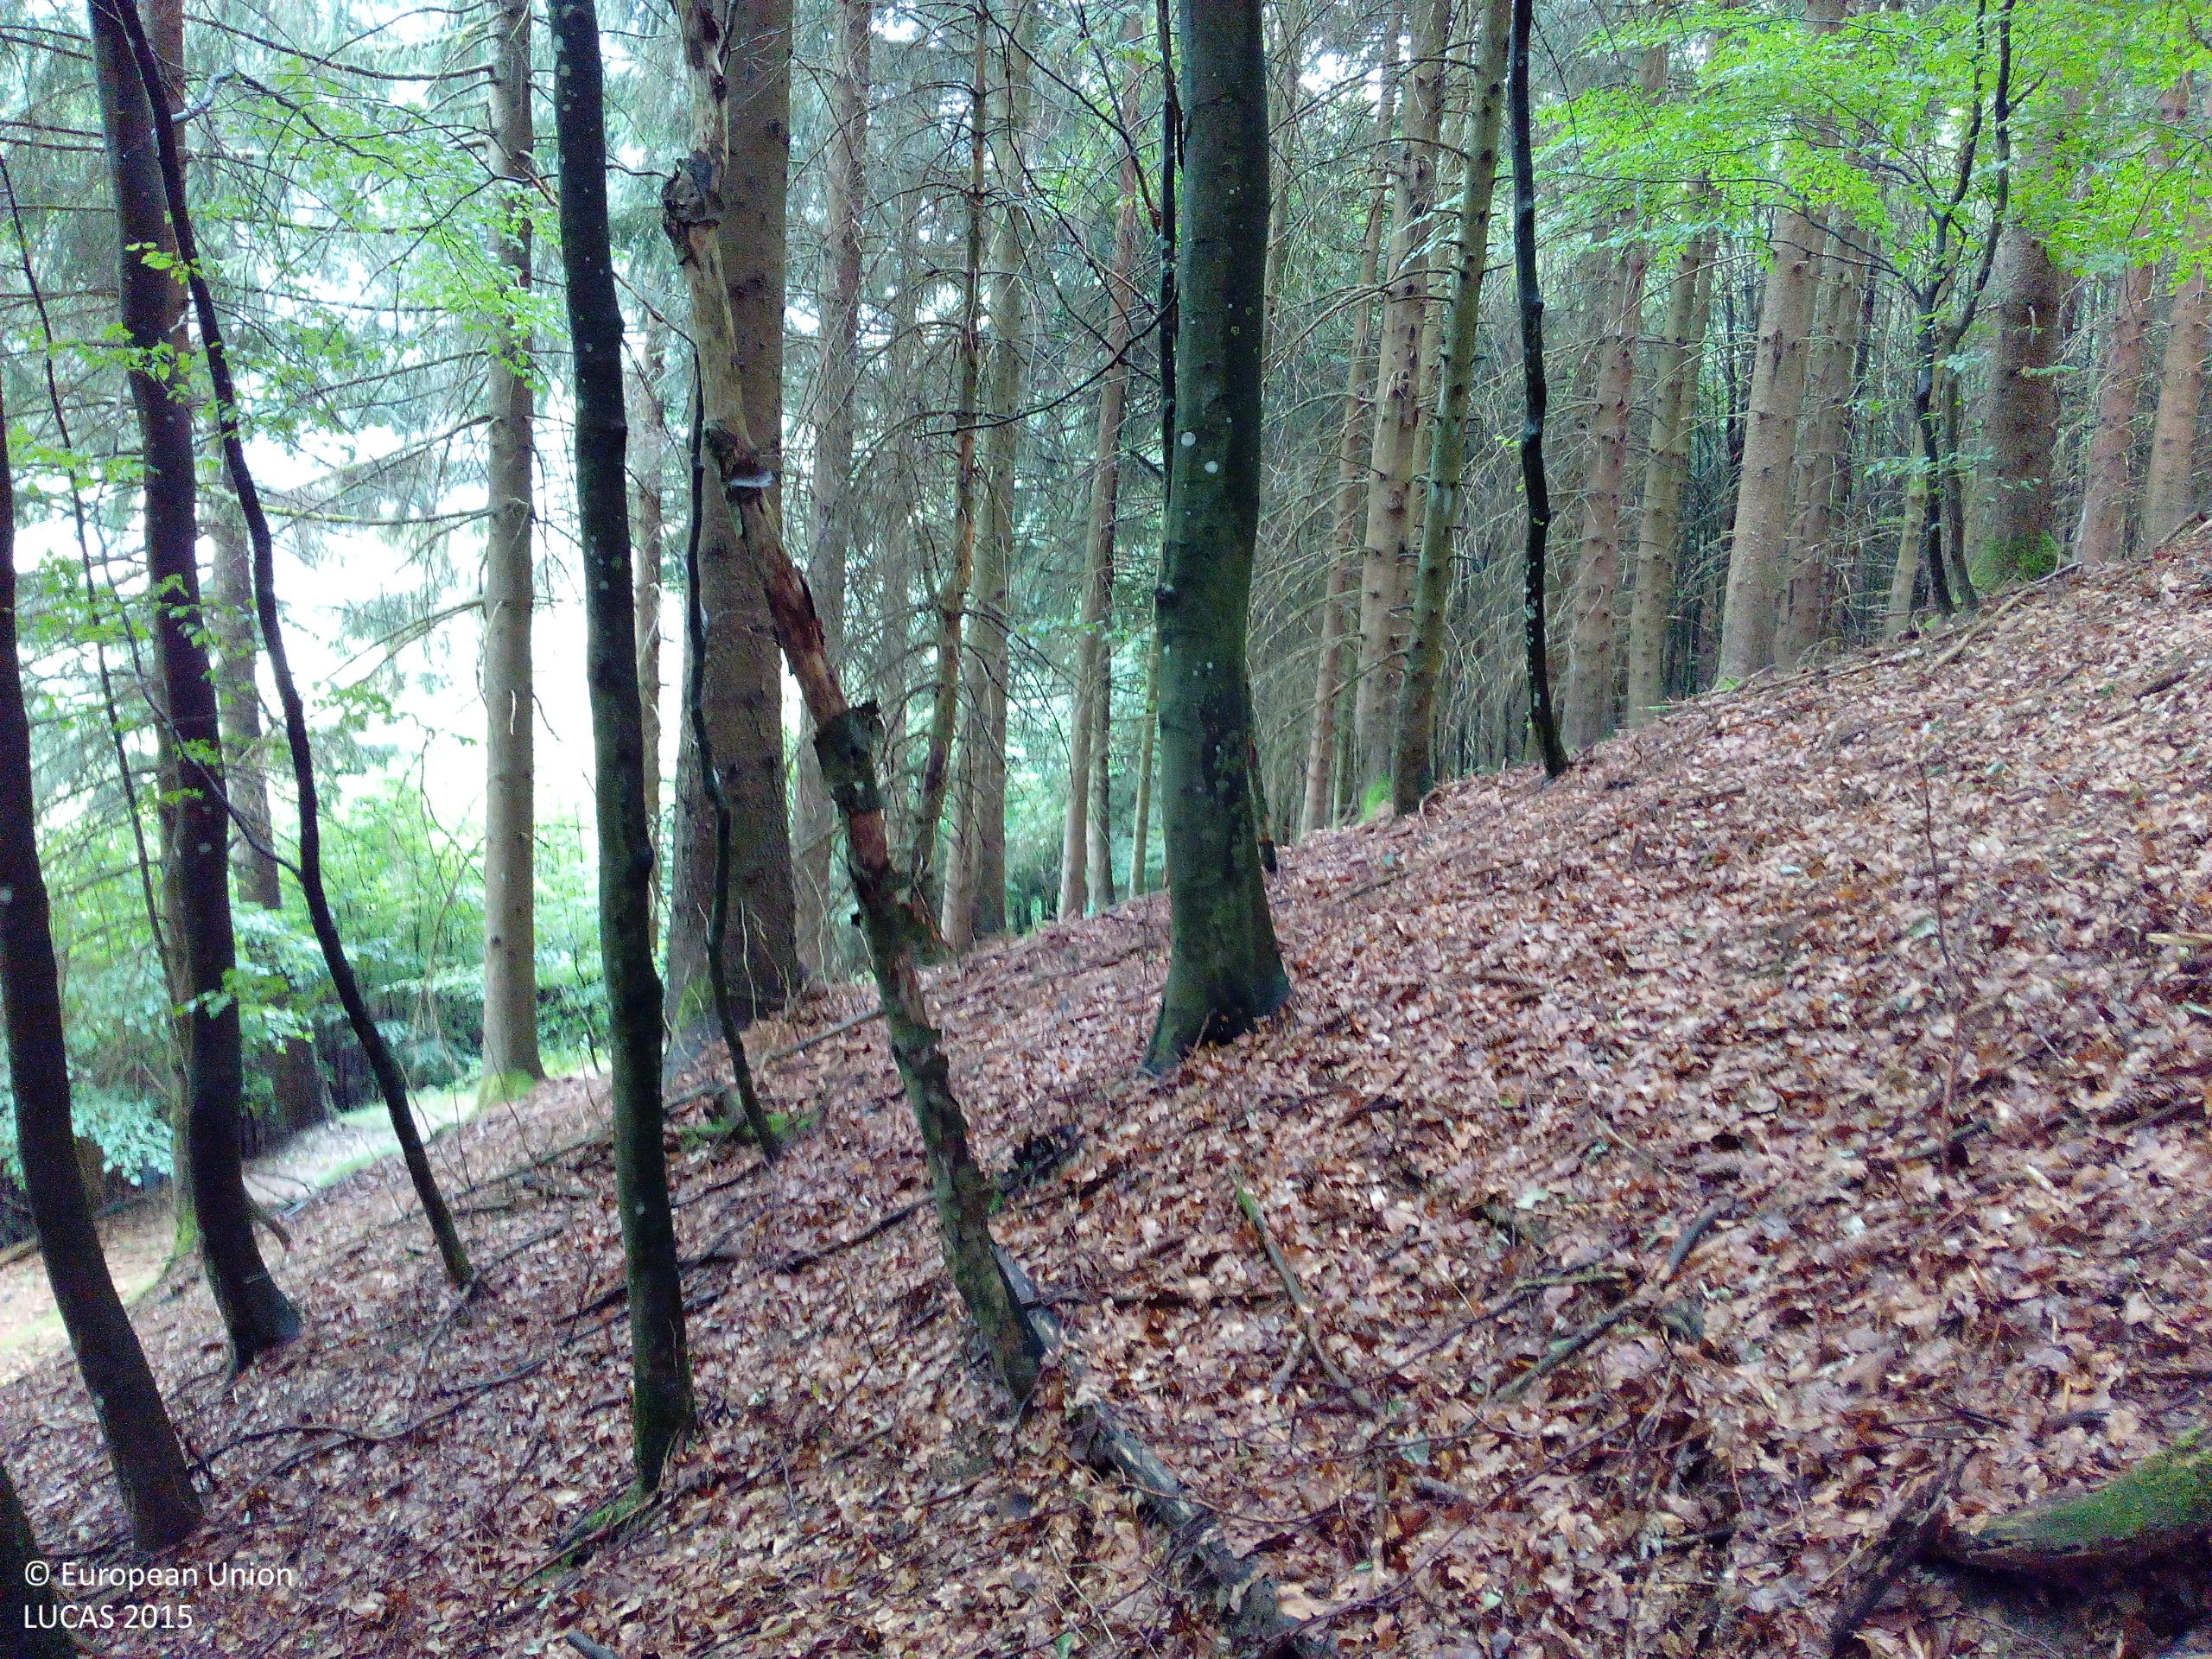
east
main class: Woodland
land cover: Broadleaved woodland
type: beech forest
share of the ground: > 75 %
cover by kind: broadleaved forest trees 90 %, unconsolidated bare surface 10 %
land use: Forestry
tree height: > 5 m
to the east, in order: Broadleaved woodland; Spruce dominated coniferous woodland; Tracks; Spruce dominated coniferous woodland; Rivers and streams; Broadleaved woodland; Spruce dominated coniferous woodland; Tracks; Broadleaved woodland; Paved roads, cycling and walking lanes; Broadleaved woodland
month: July
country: DE
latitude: 48.1713
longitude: 8.1050
